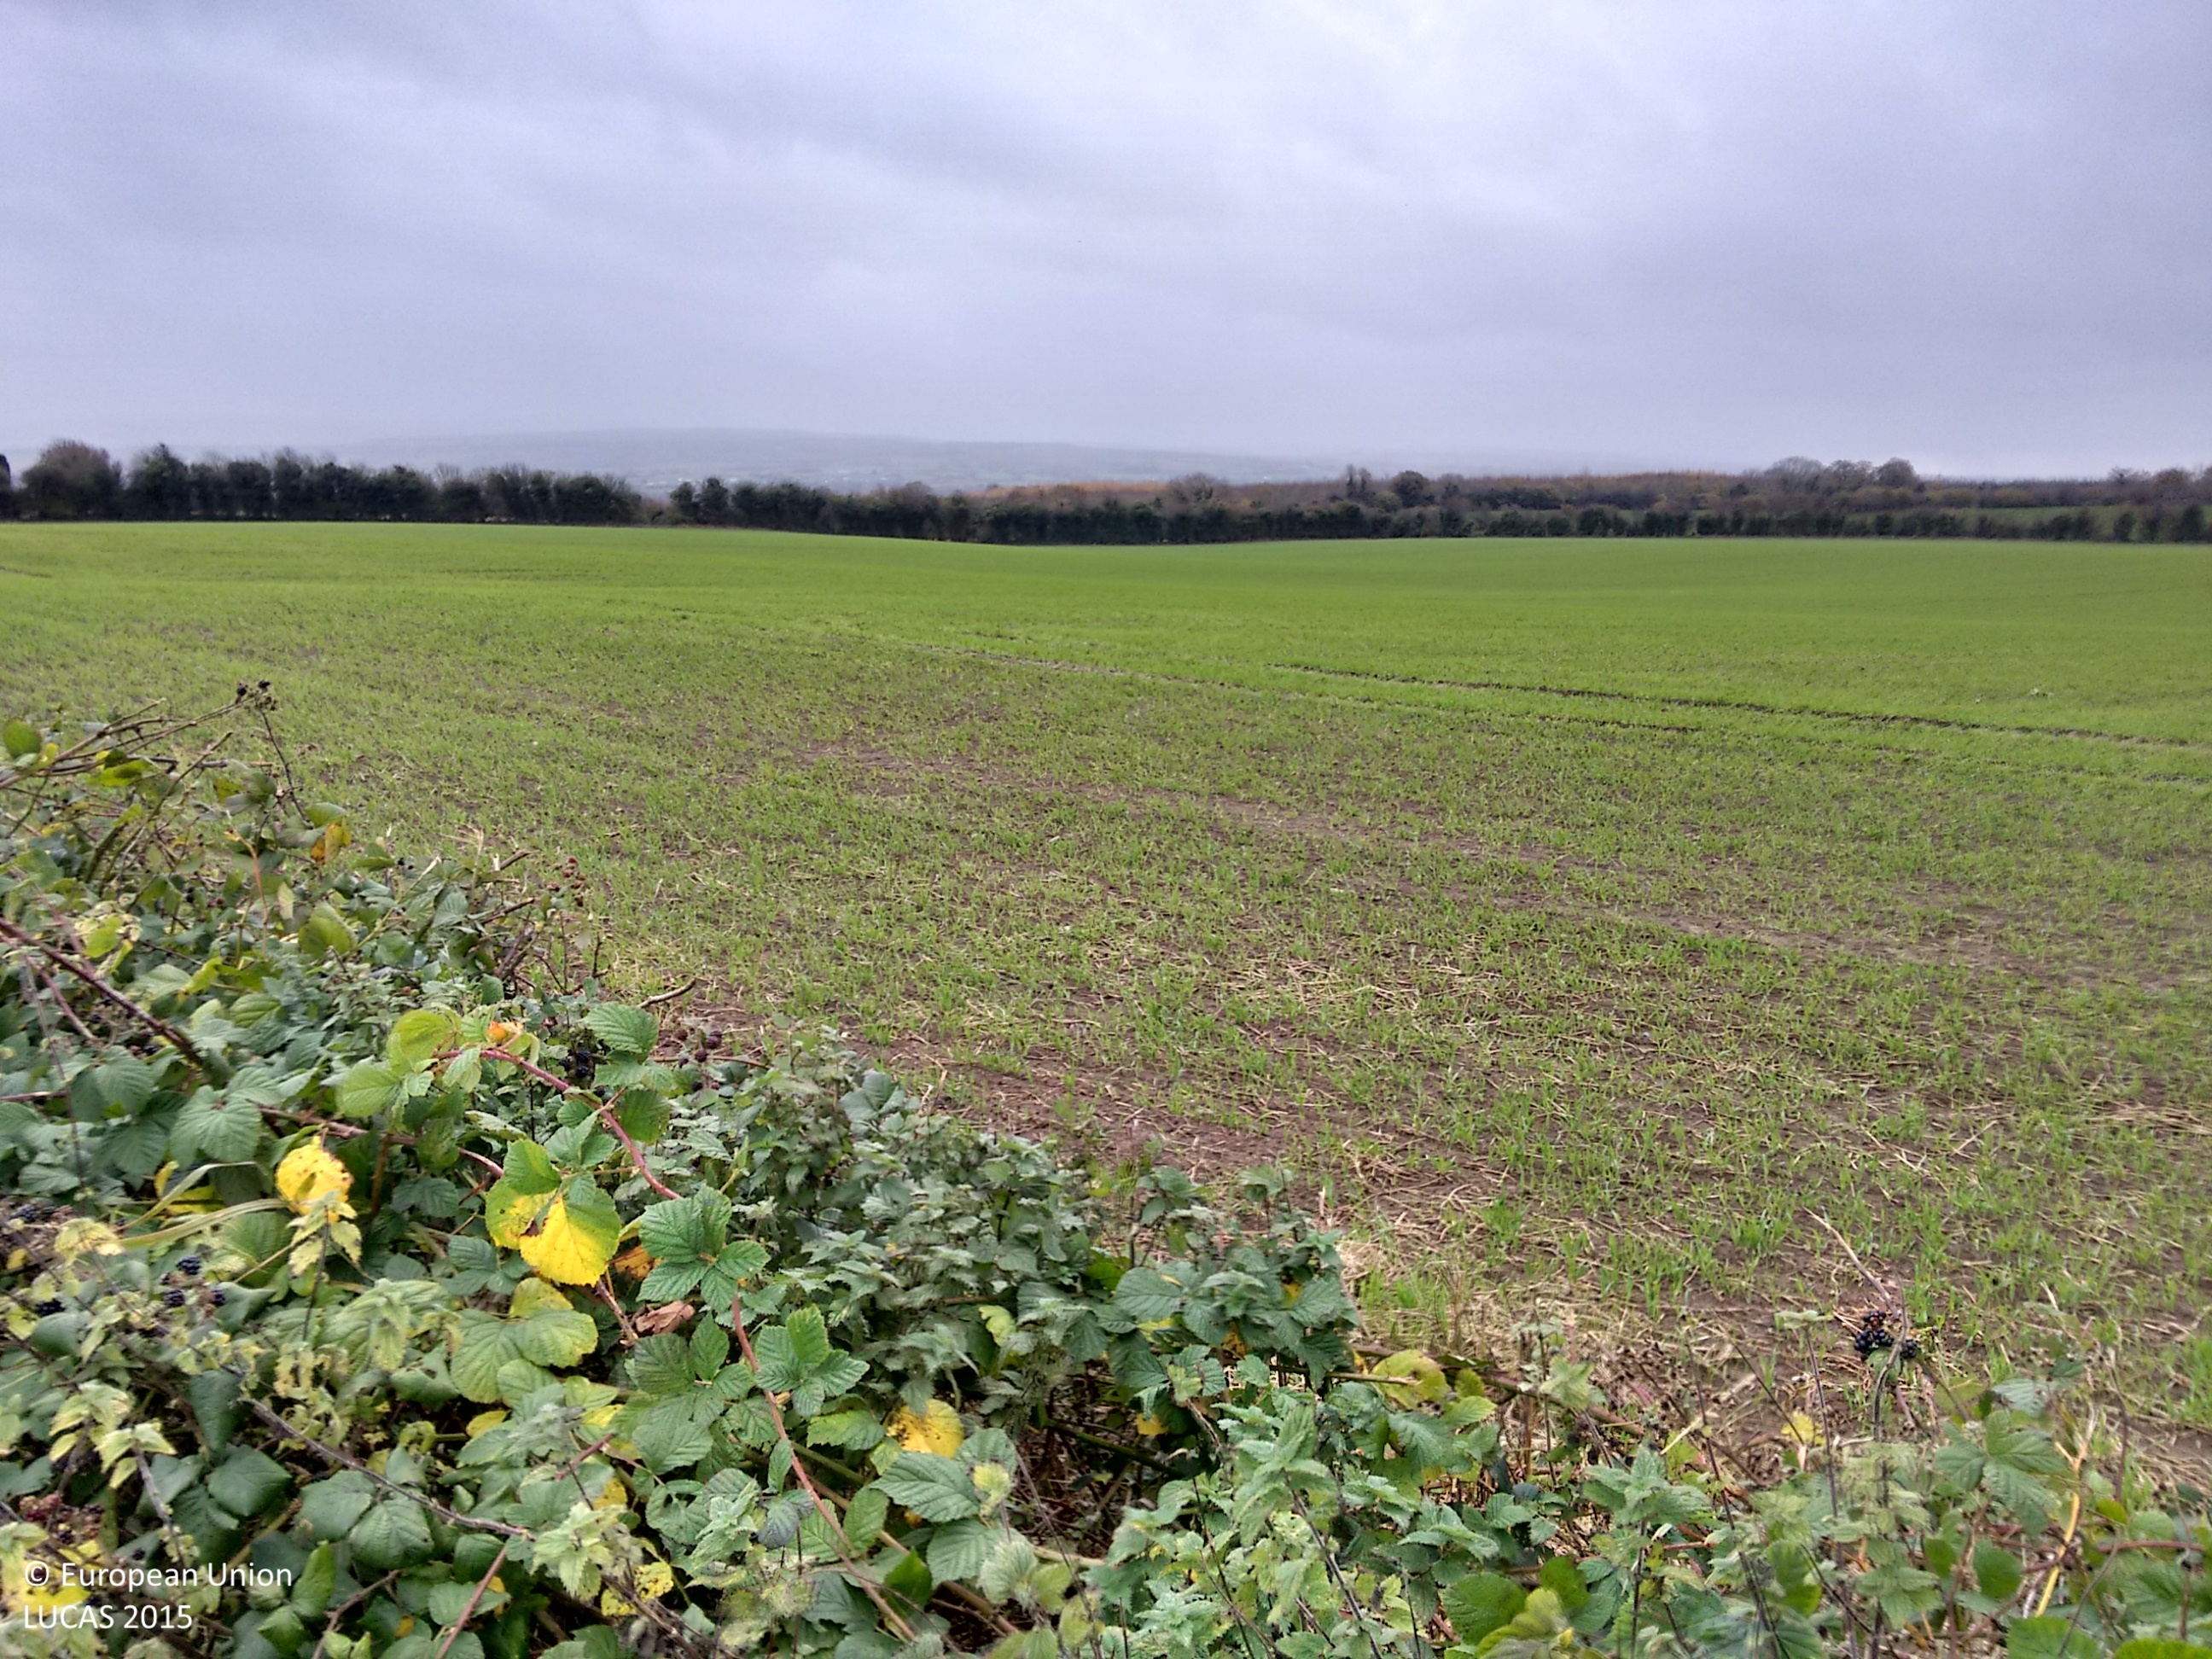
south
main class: Cropland
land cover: Common wheat
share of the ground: > 75 %
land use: Agriculture (excluding fallow land and kitchen gardens)
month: November
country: IE
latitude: 53.1857
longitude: -7.5958
